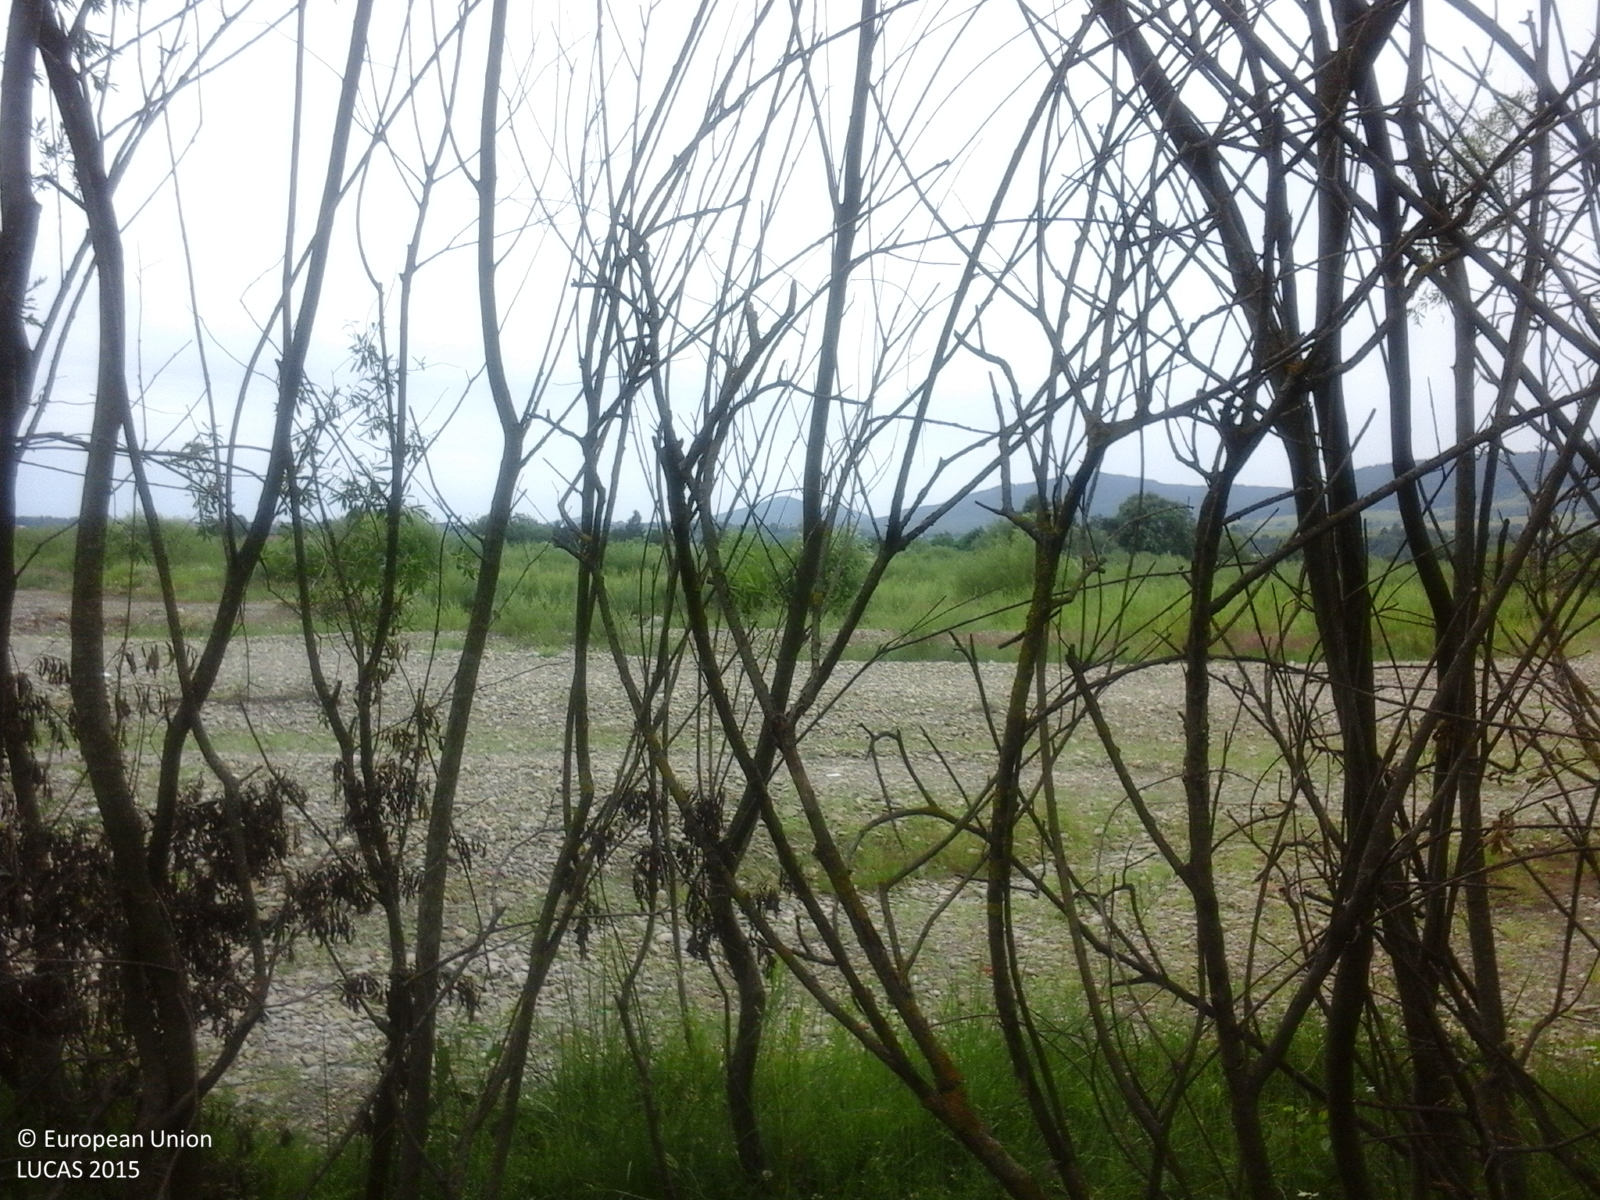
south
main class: Woodland
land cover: Broadleaved woodland
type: thermophilous deciduous forest
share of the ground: > 75 %
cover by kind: broadleaved forest trees 85 %, herbaceous plants 15 %
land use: Semi-natural and natural areas not in use
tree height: > 5 m
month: June
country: RO
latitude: 47.9163
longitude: 25.6856
